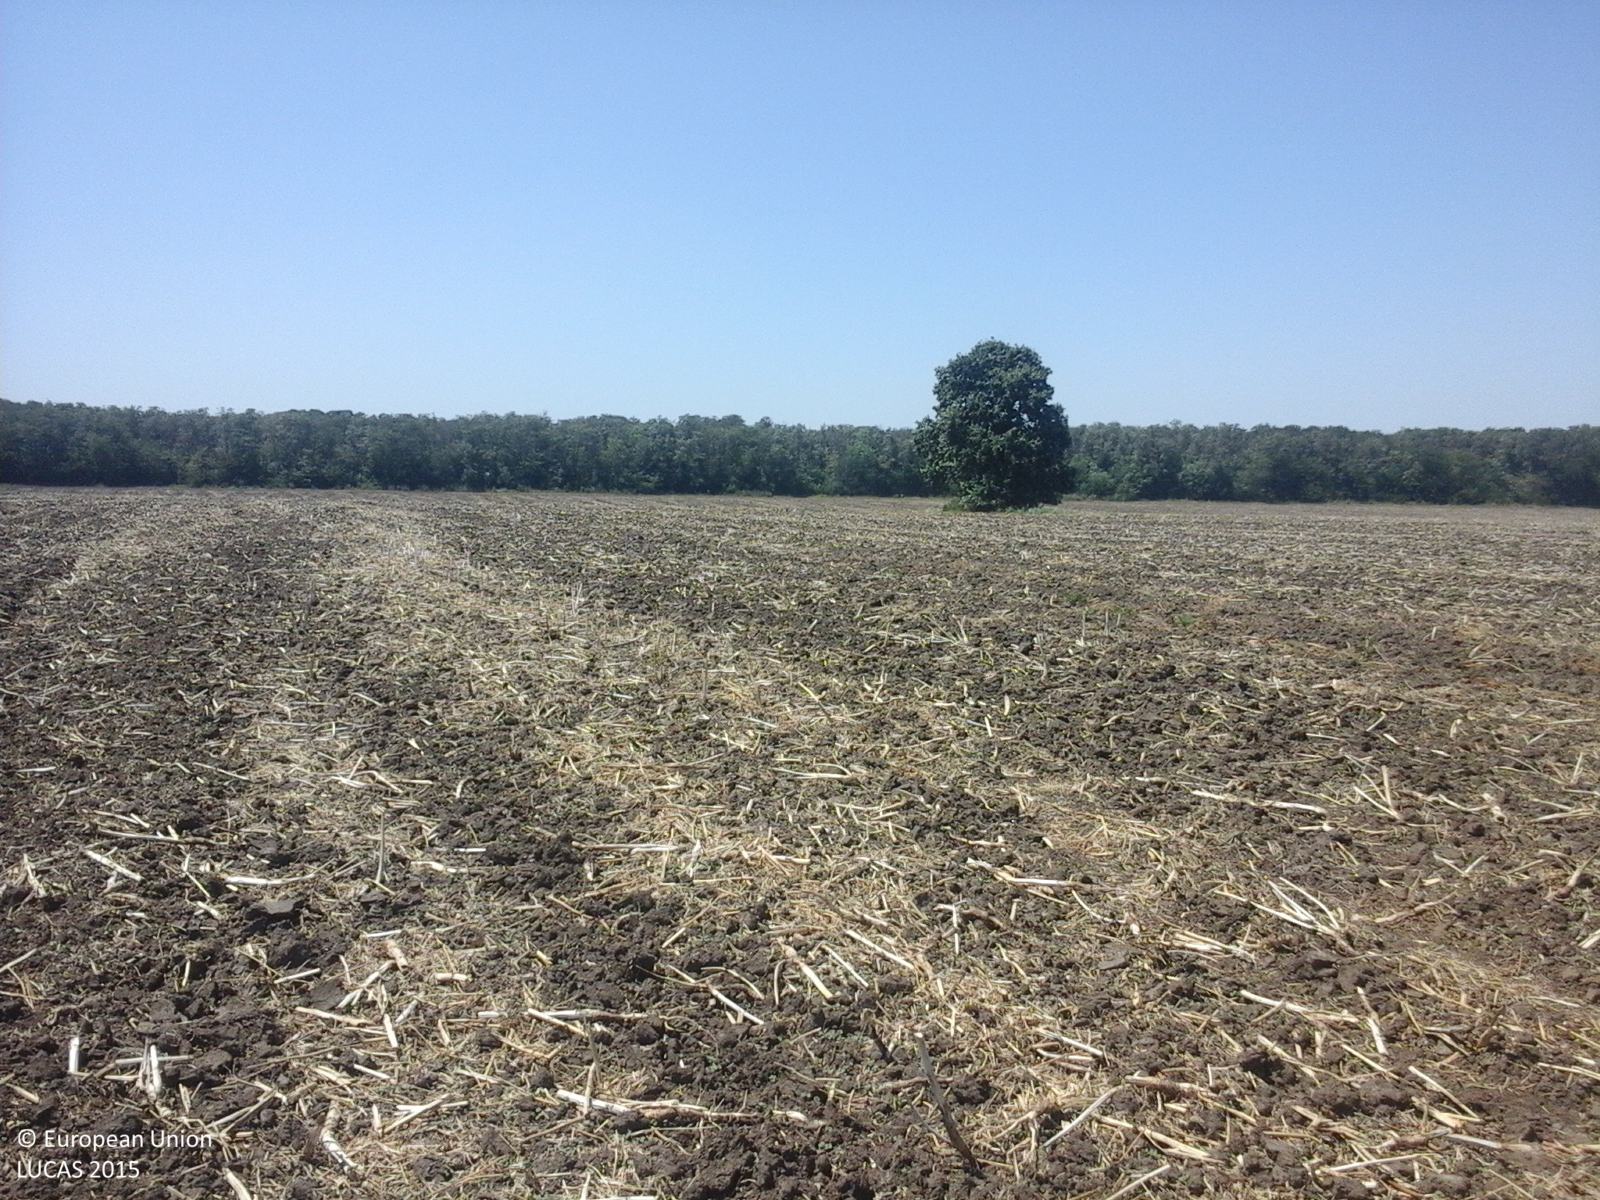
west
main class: Cropland
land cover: Rape and turnip rape
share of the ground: < 10 %
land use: Agriculture (excluding fallow land and kitchen gardens)
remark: Harvested field
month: July
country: RO
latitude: 44.1861
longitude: 26.6674
